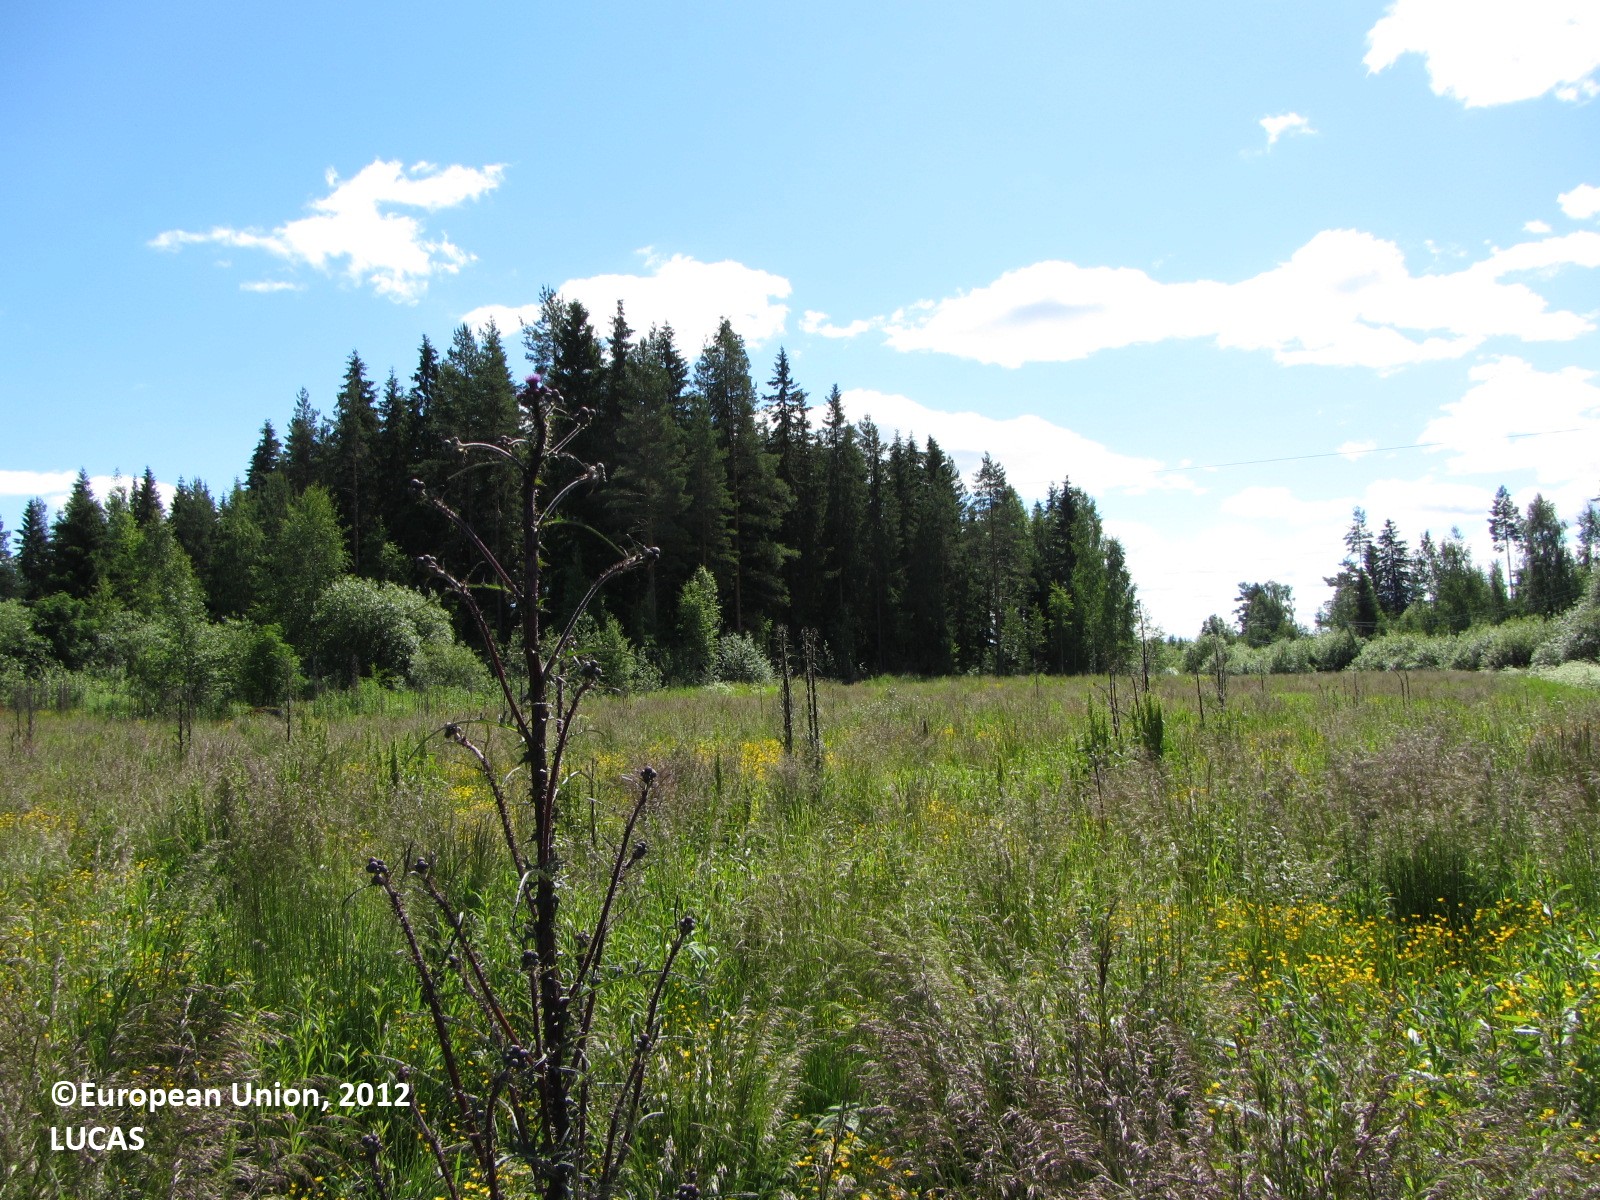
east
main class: Grassland
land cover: Spontaneously vegetated surfaces
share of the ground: > 75 %
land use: Fallow land
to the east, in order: Spontaneously vegetated surfaces; Ditches and canals; Spontaneously vegetated surfaces; Ditches and canals; Spontaneously vegetated surfaces; Paved roads, cycling and walking lanes; Spontaneously vegetated surfaces; Ditches and canals; Abandoned hedges; Pine dominated mixed woodland; Ponds and wetlands; Pine dominated mixed woodland; Tracks; Pine dominated mixed woodland; Tracks; Pine dominated mixed woodland; Tracks; Pine dominated mixed woodland; Ditches and canals; Pine dominated mixed woodland
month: June
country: FI
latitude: 62.6000
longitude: 25.2788
